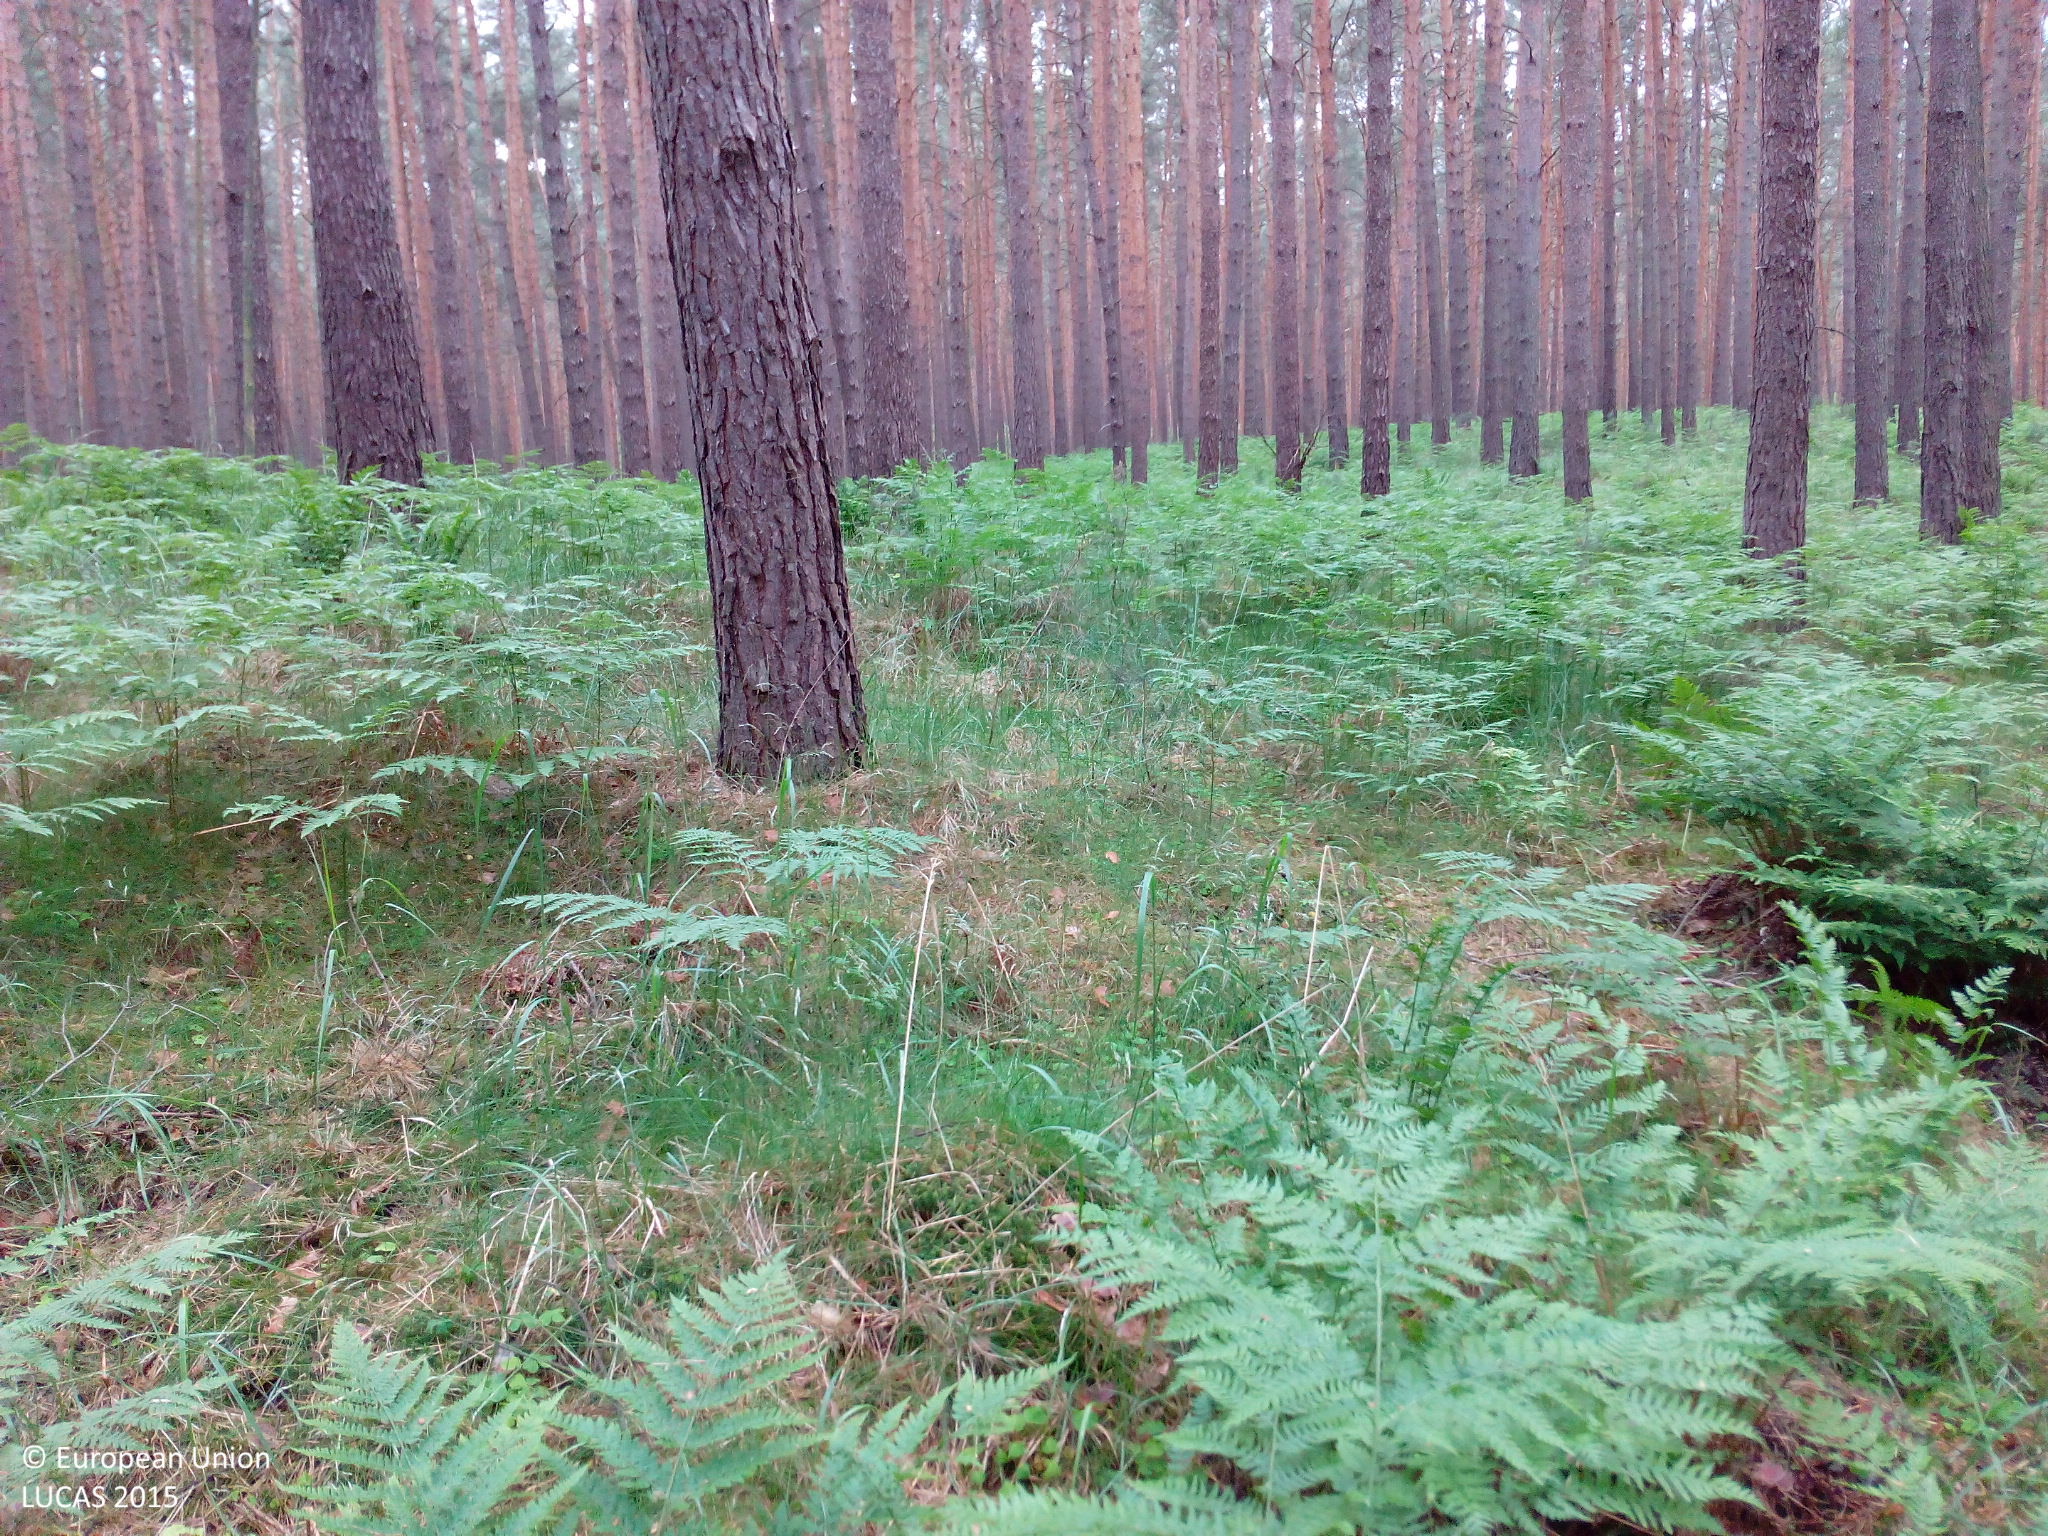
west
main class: Woodland
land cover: Pine dominated coniferous woodland
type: hemiboreal forest and nemoral coniferous forest and mixed broadleaved-coniferous forest
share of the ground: > 75 %
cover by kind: coniferous forest trees 85 %, shrubs 5 %, herbaceous plants 5 %, lichens and mosses 5 %
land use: Forestry
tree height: > 5 m
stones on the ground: < 10 %
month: June
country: DE
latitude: 52.1874
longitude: 12.5887
